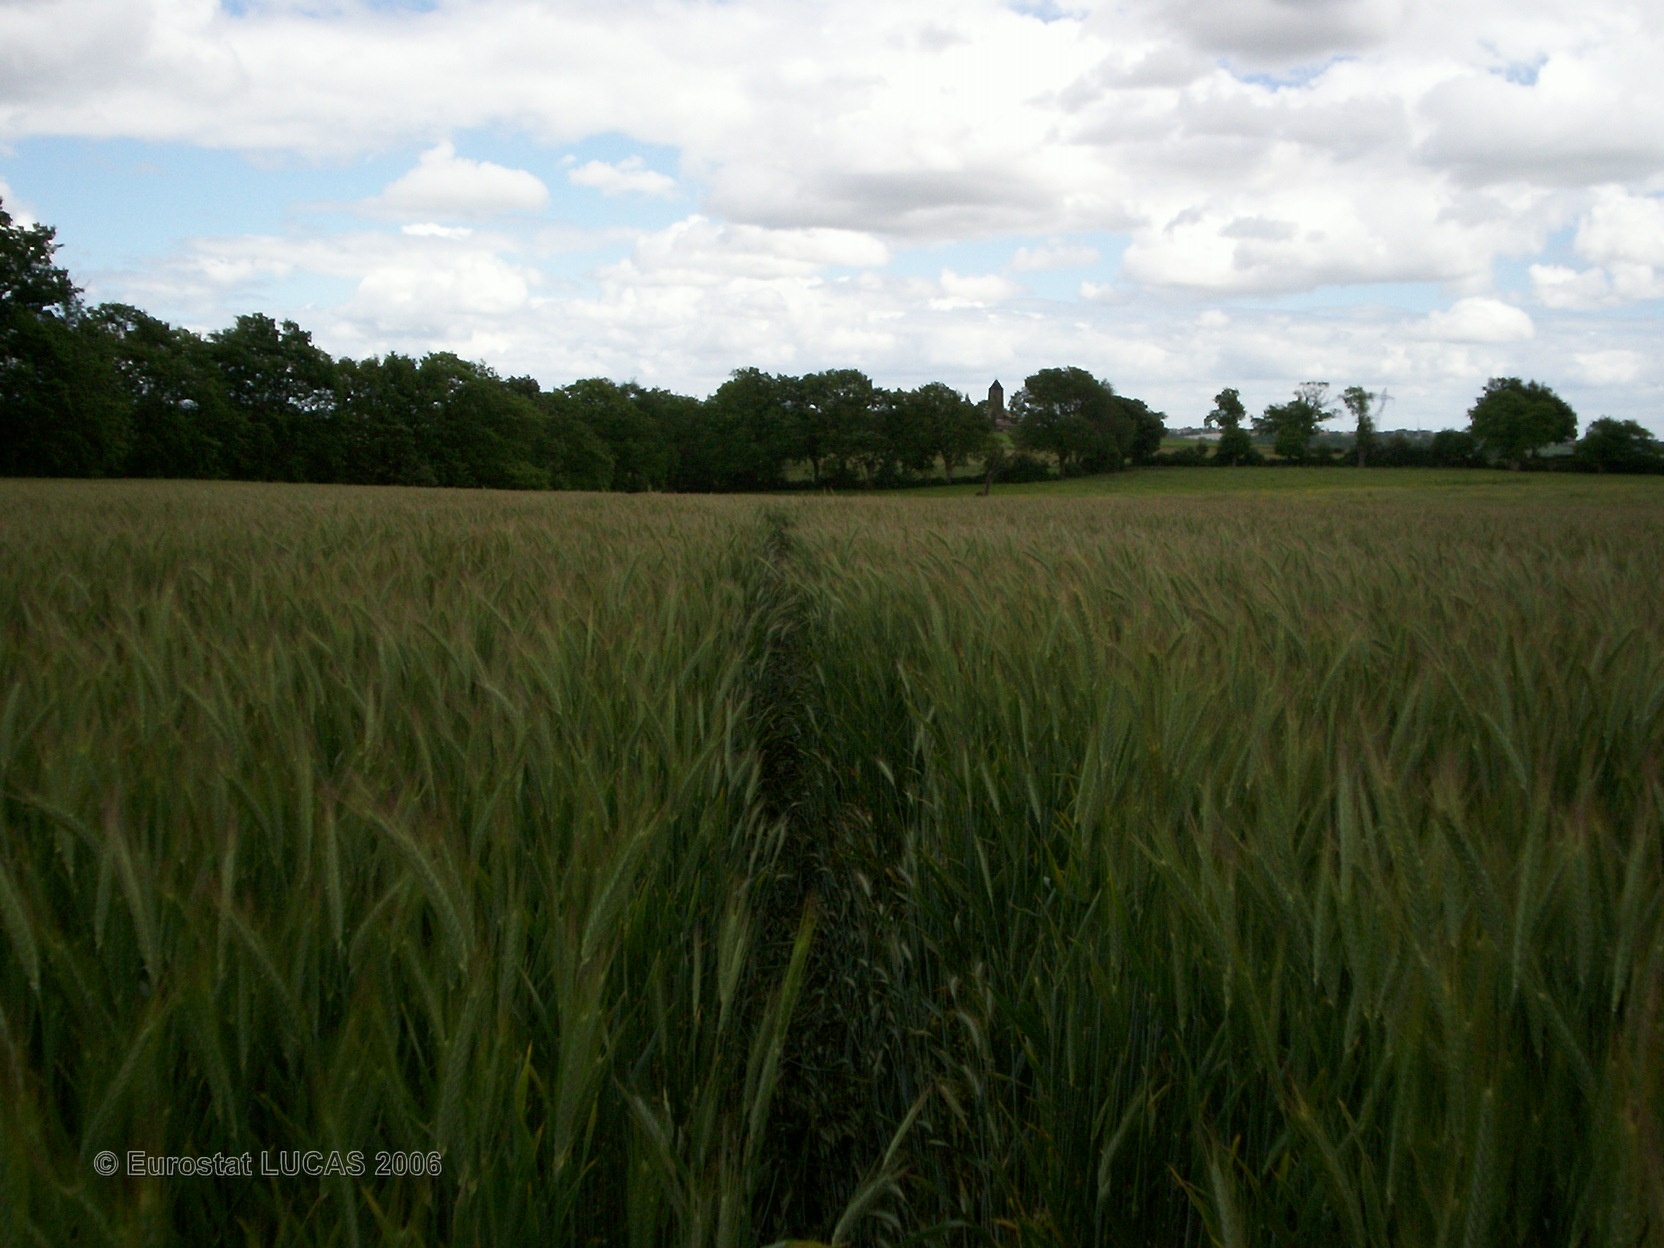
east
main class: Cropland
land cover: Triticale
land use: Agriculture (excluding fallow land and kitchen gardens)
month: May
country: FR
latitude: 47.2822
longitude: -1.0759
